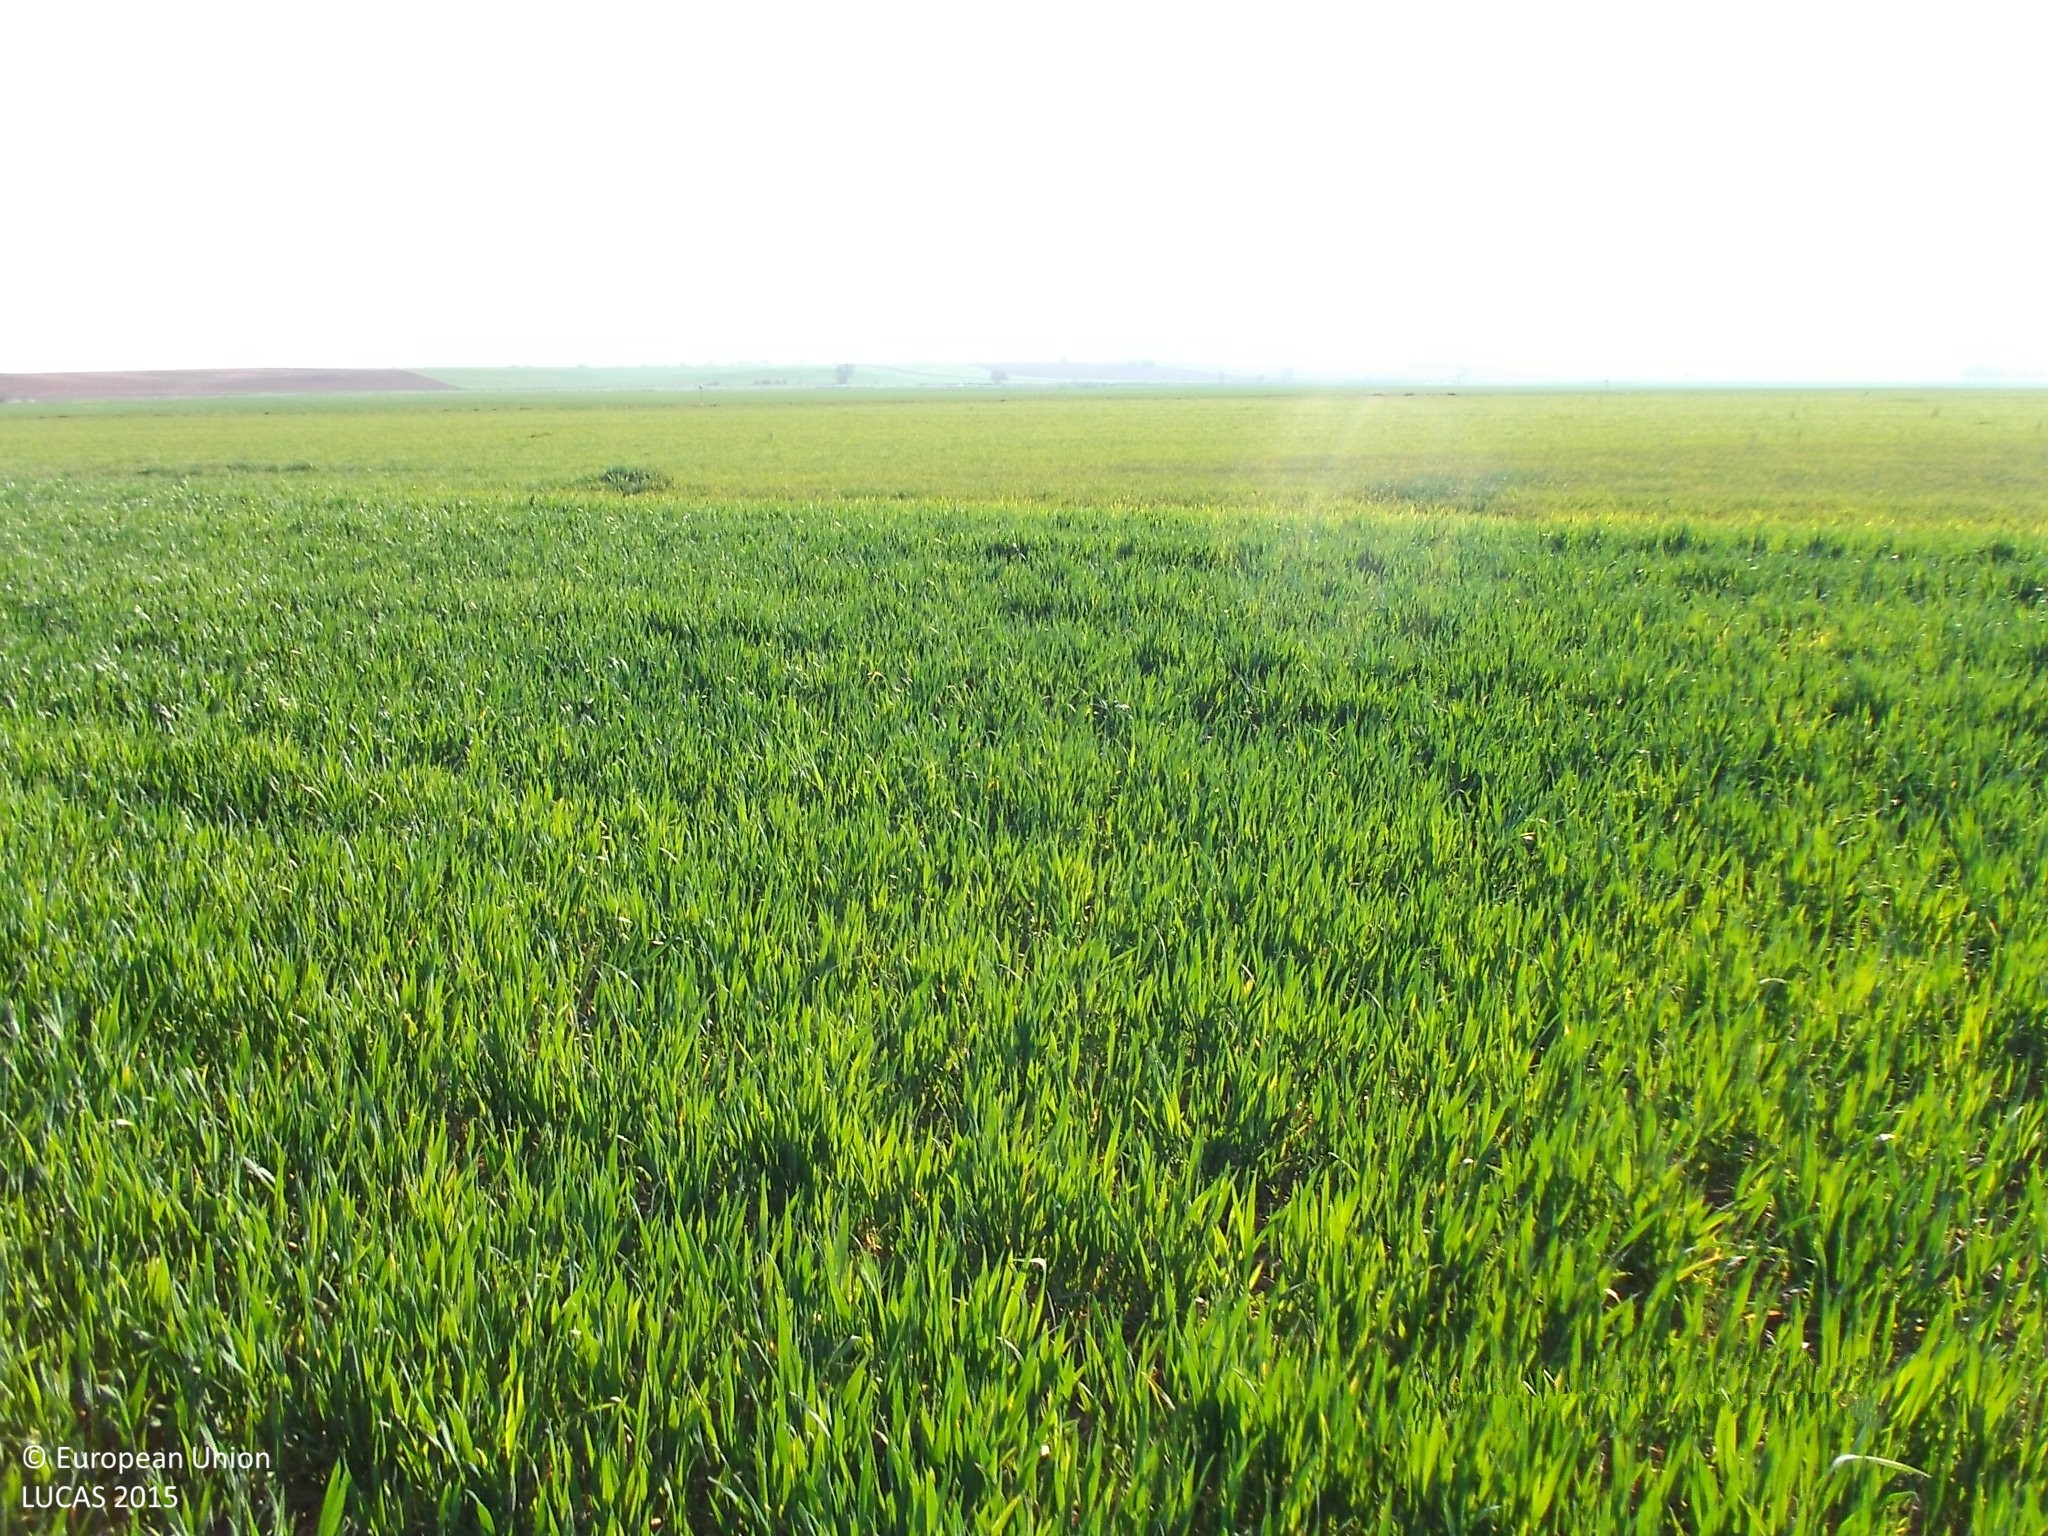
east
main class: Cropland
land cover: Common wheat
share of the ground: > 75 %
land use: Agriculture (excluding fallow land and kitchen gardens)
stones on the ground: 10 - 25 %
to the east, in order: Common wheat; Oats; Grass margins; Tracks; Common wheat
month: April
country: ES
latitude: 40.8921
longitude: -5.9025
